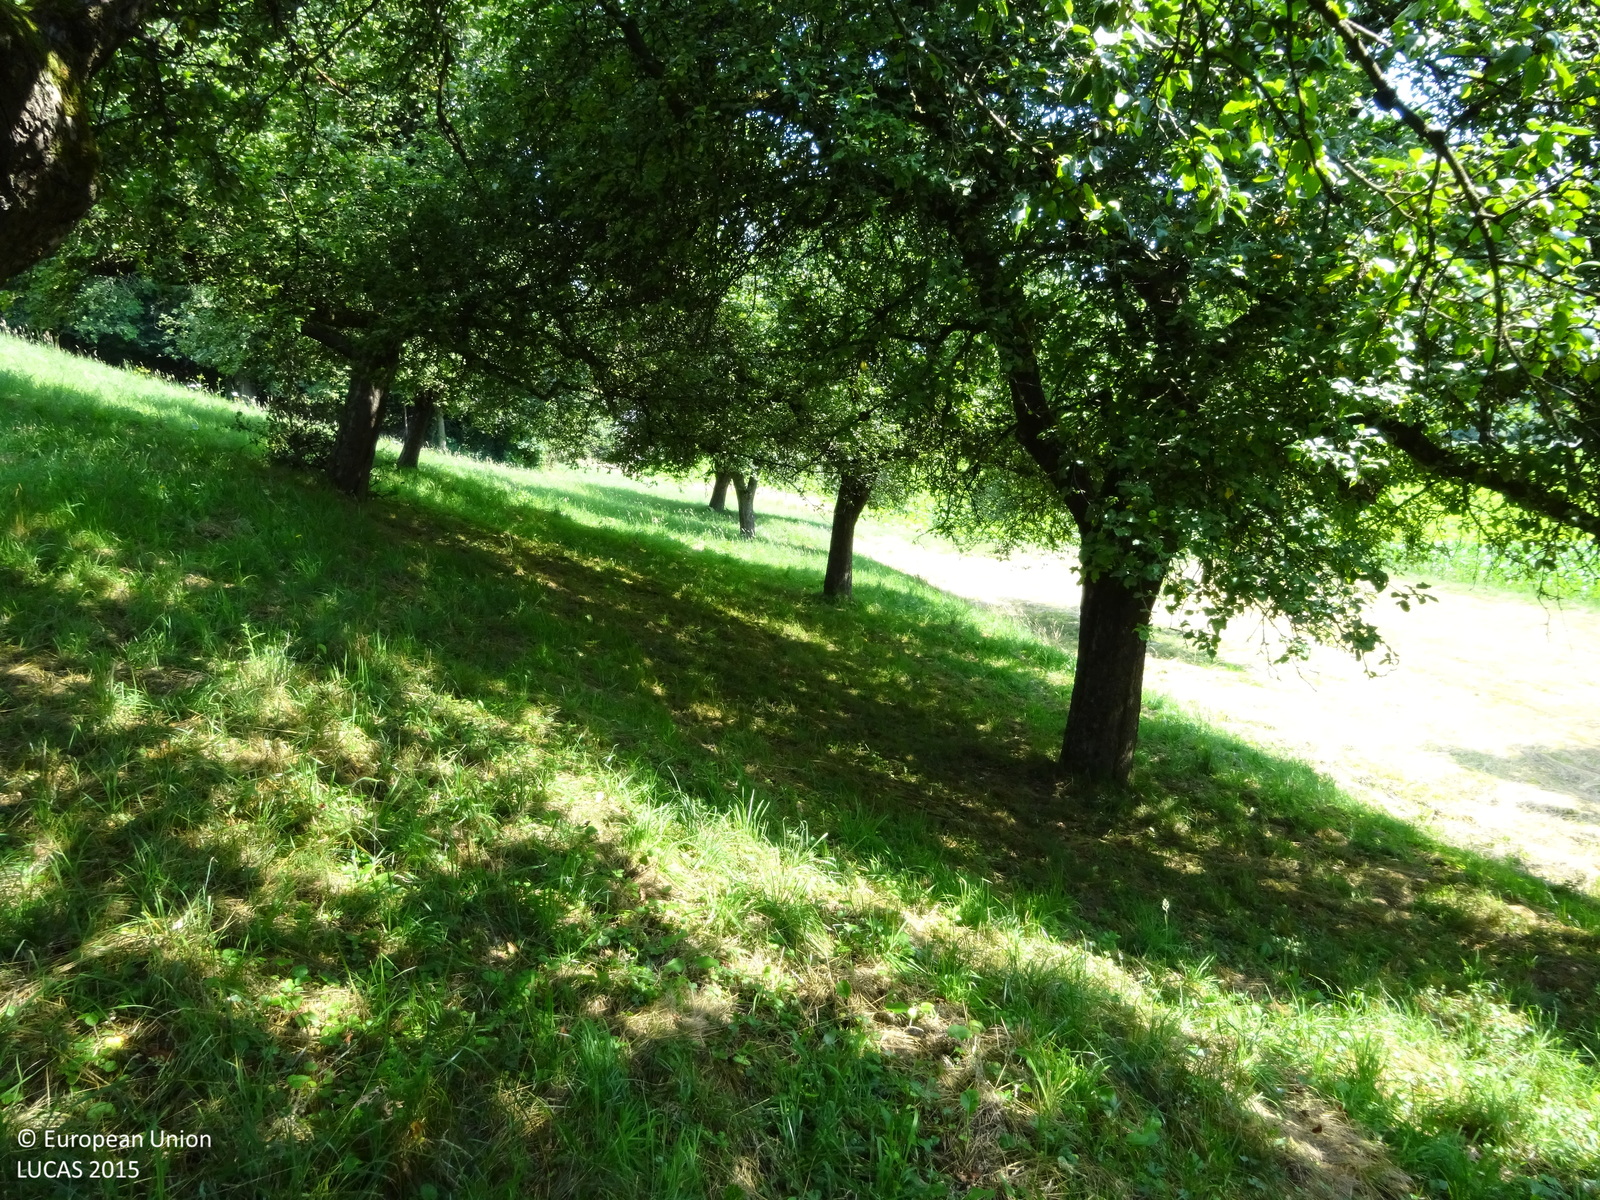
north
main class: Cropland
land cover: Apple fruit
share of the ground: > 75 %
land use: Agriculture (excluding fallow land and kitchen gardens)
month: July
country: AT
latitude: 46.9065
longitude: 15.9741
